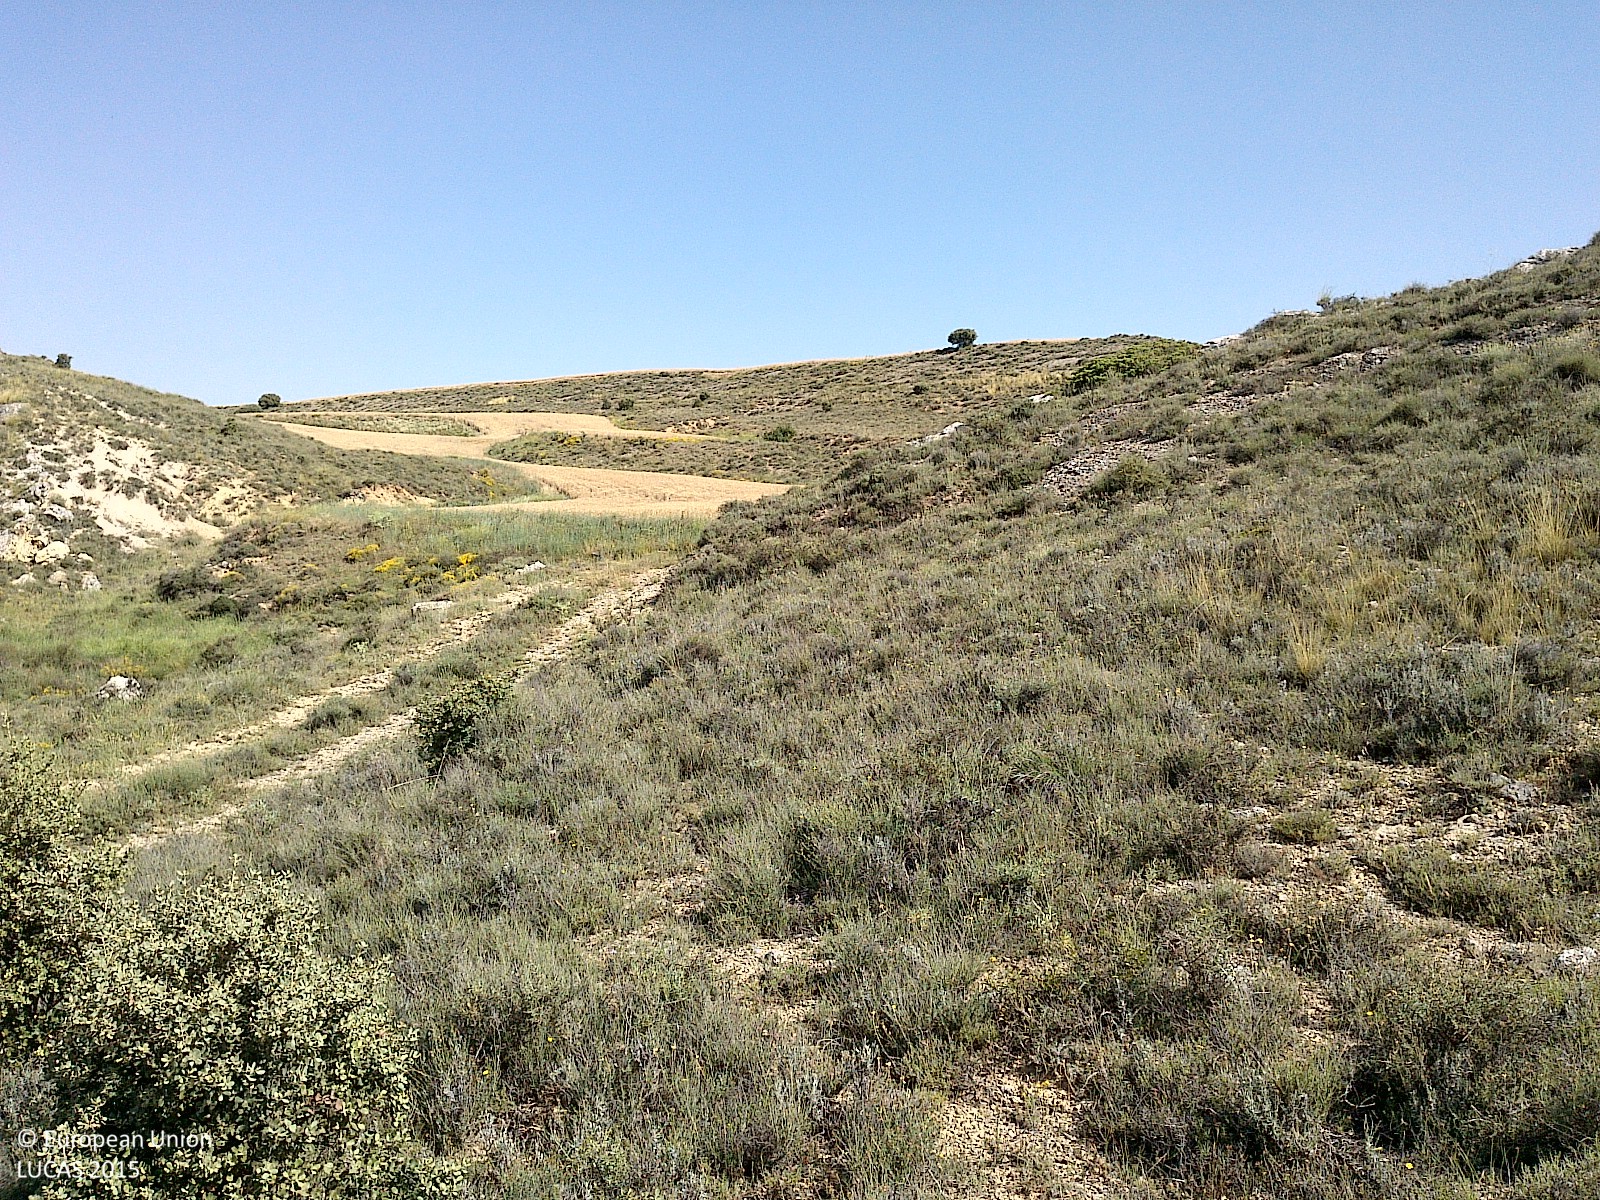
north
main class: Shrubland
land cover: Shrubland without tree cover
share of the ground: > 75 %
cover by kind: shrubs 75 %, unconsolidated bare surface 20 %, consolidated bare surface 5 %
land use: Semi-natural and natural areas not in use
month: July
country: ES
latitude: 41.5365
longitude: -2.1502
